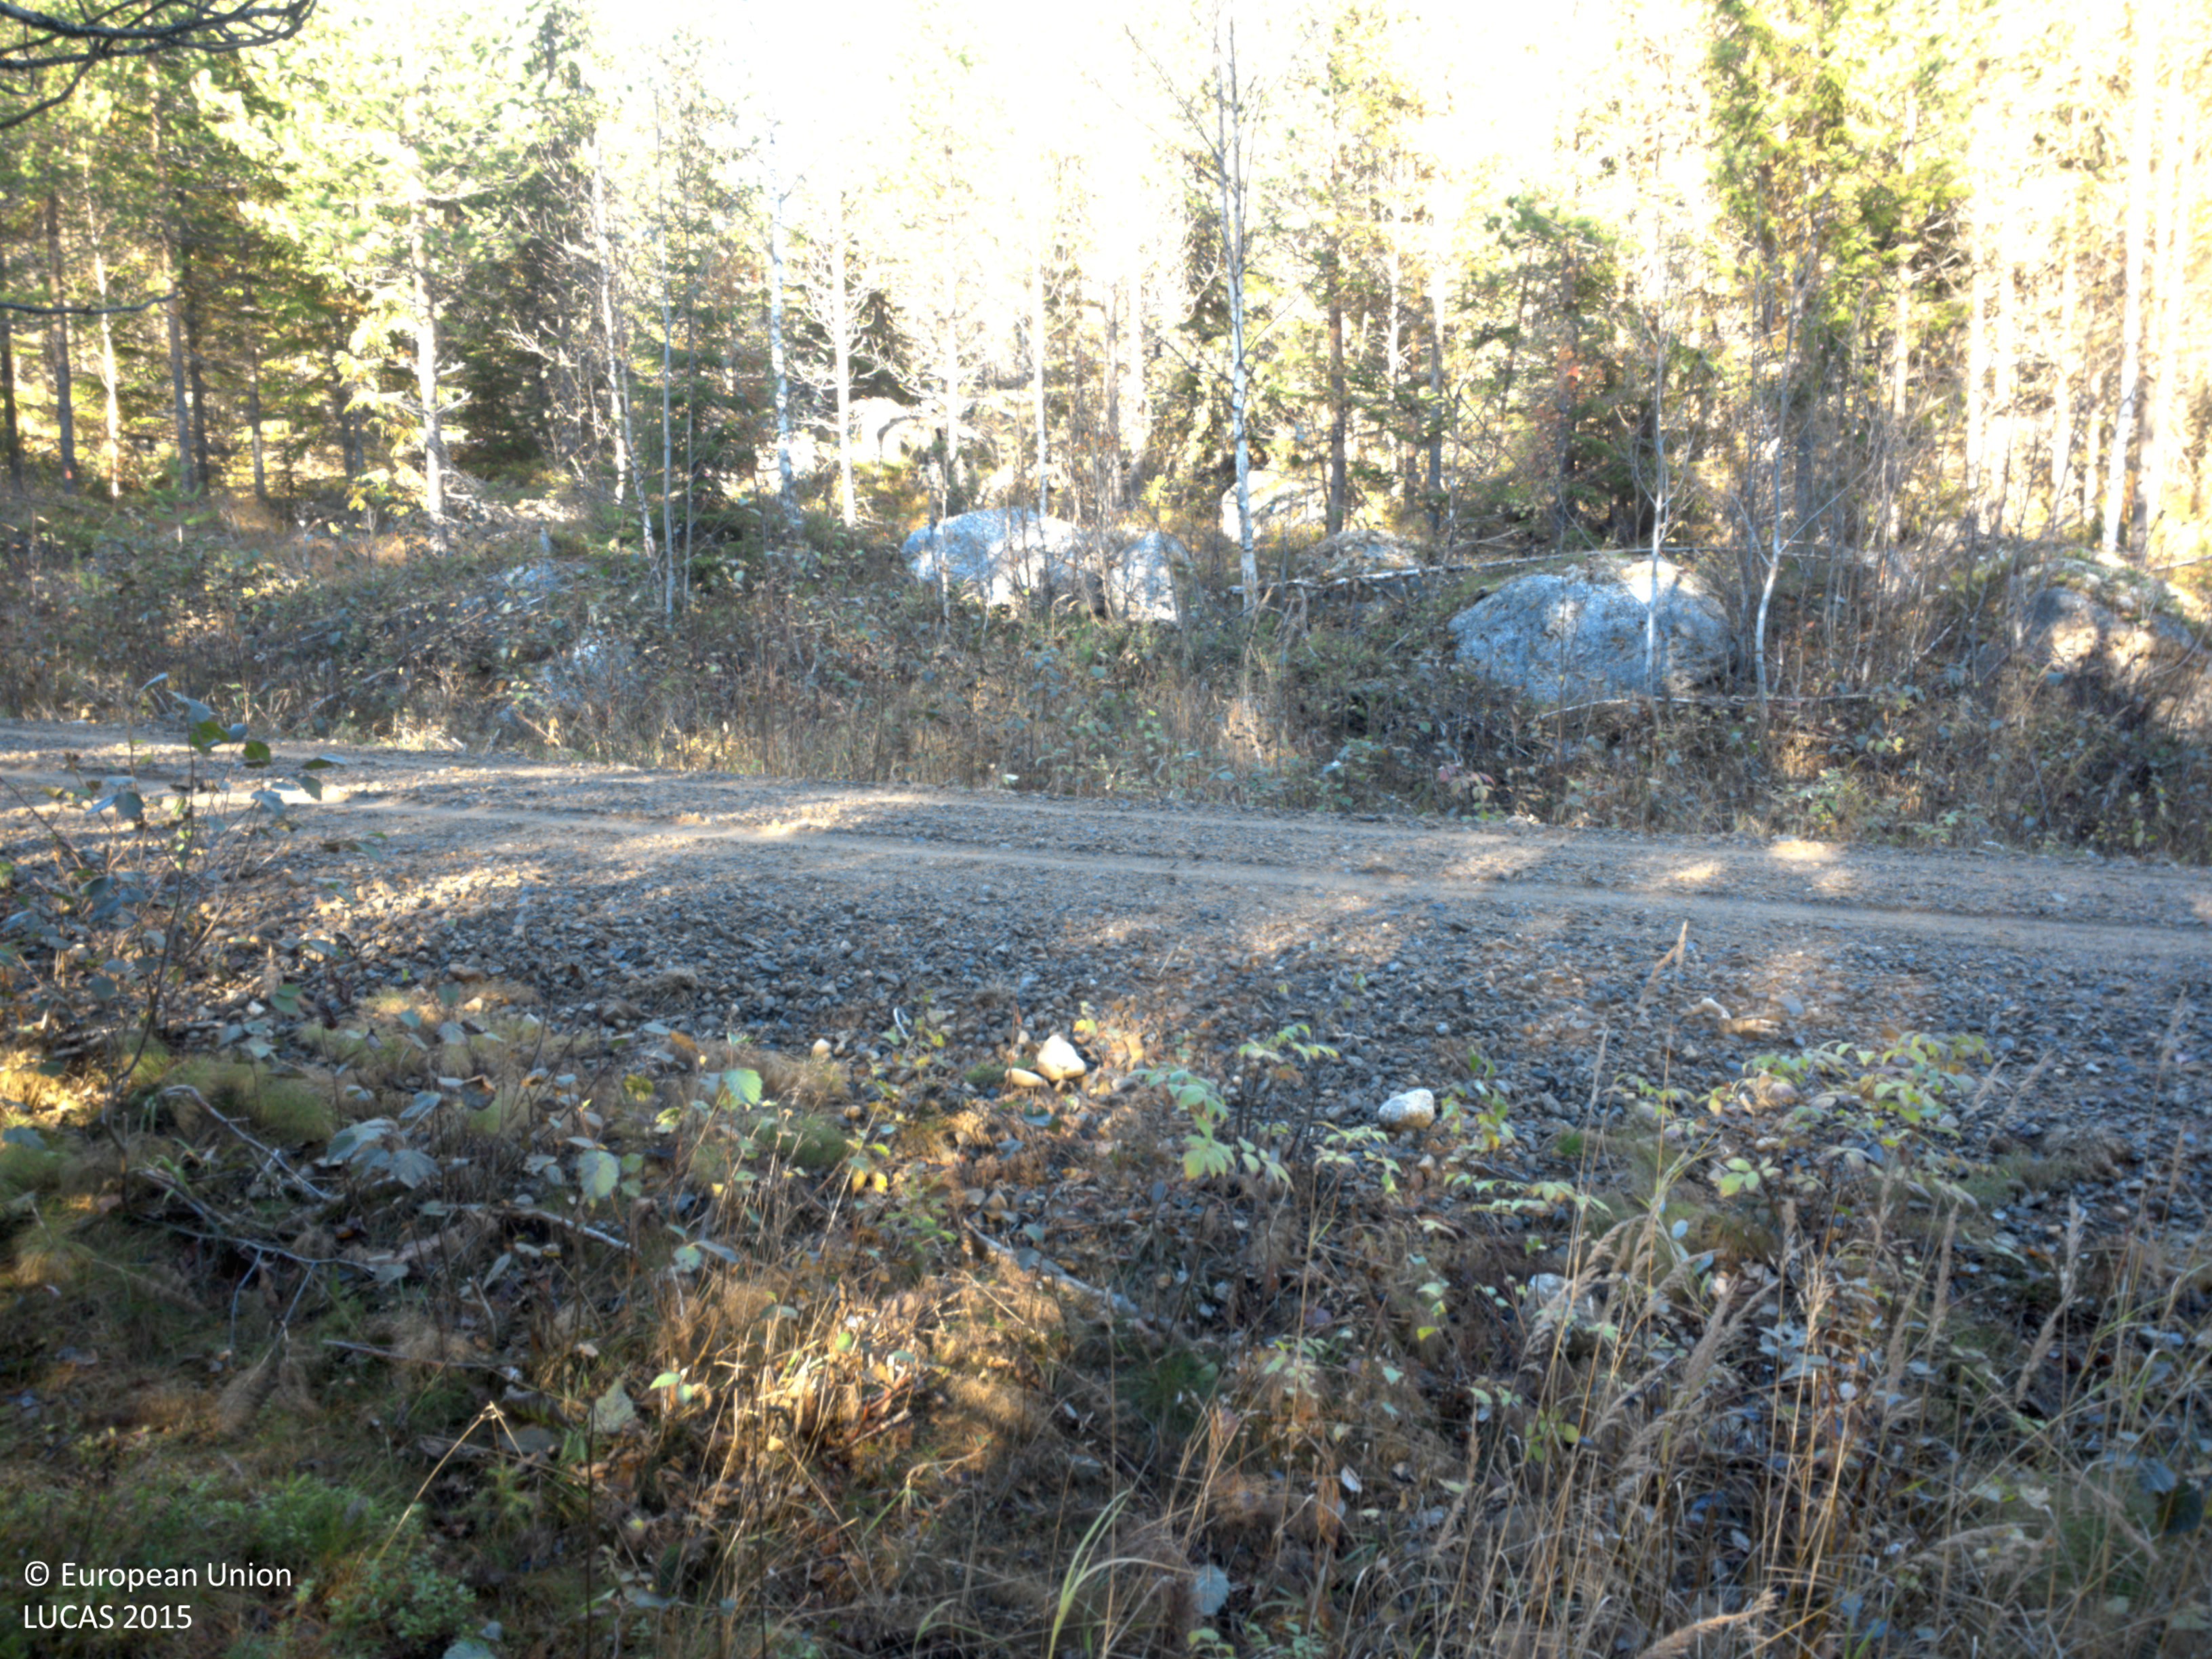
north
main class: Woodland
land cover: Pine dominated coniferous woodland
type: boreal forest
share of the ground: > 75 %
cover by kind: coniferous forest trees 85 %, shrubs 10 %, lichens and mosses 5 %
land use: Forestry
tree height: > 5 m
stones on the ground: < 10 %
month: October
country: SE
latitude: 63.8792
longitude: 18.8299
